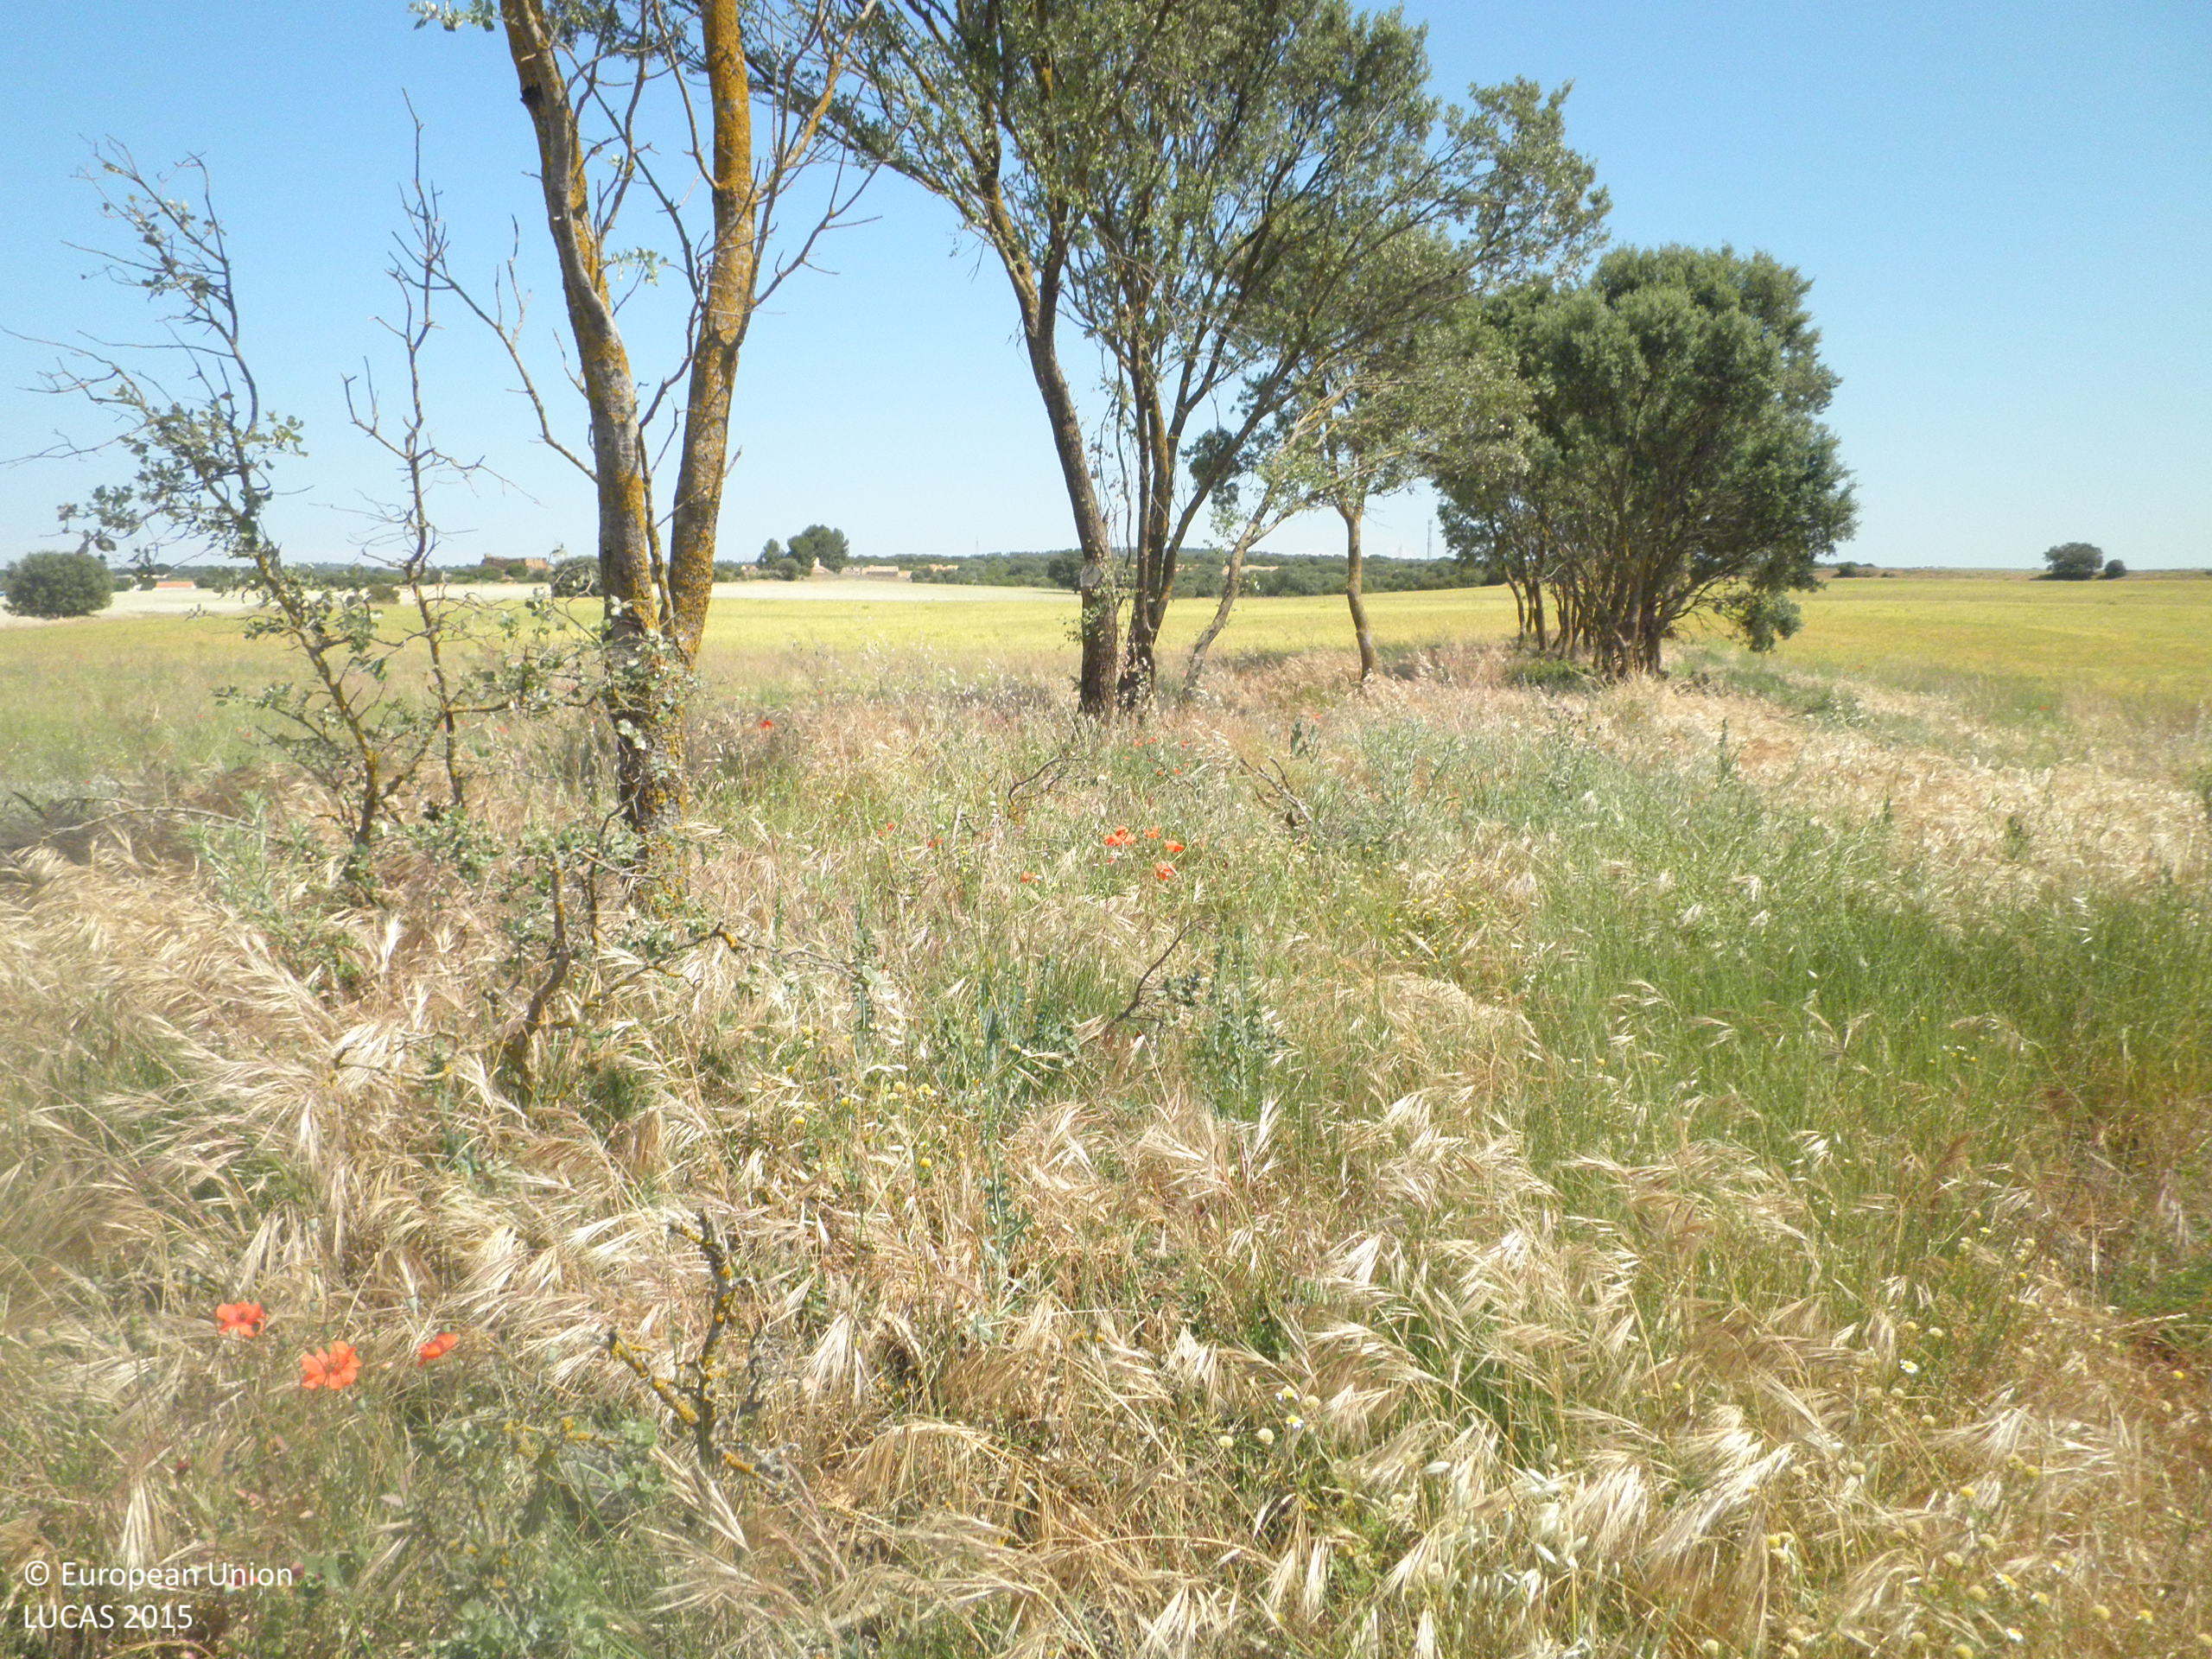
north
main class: Woodland
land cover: Broadleaved woodland
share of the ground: > 75 %
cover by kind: herbaceous plants 60 %, unconsolidated bare surface 25 %, broadleaved forest trees 15 %
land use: Semi-natural and natural areas not in use
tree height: < 5 m
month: June
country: ES
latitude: 39.5145
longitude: -1.8123
